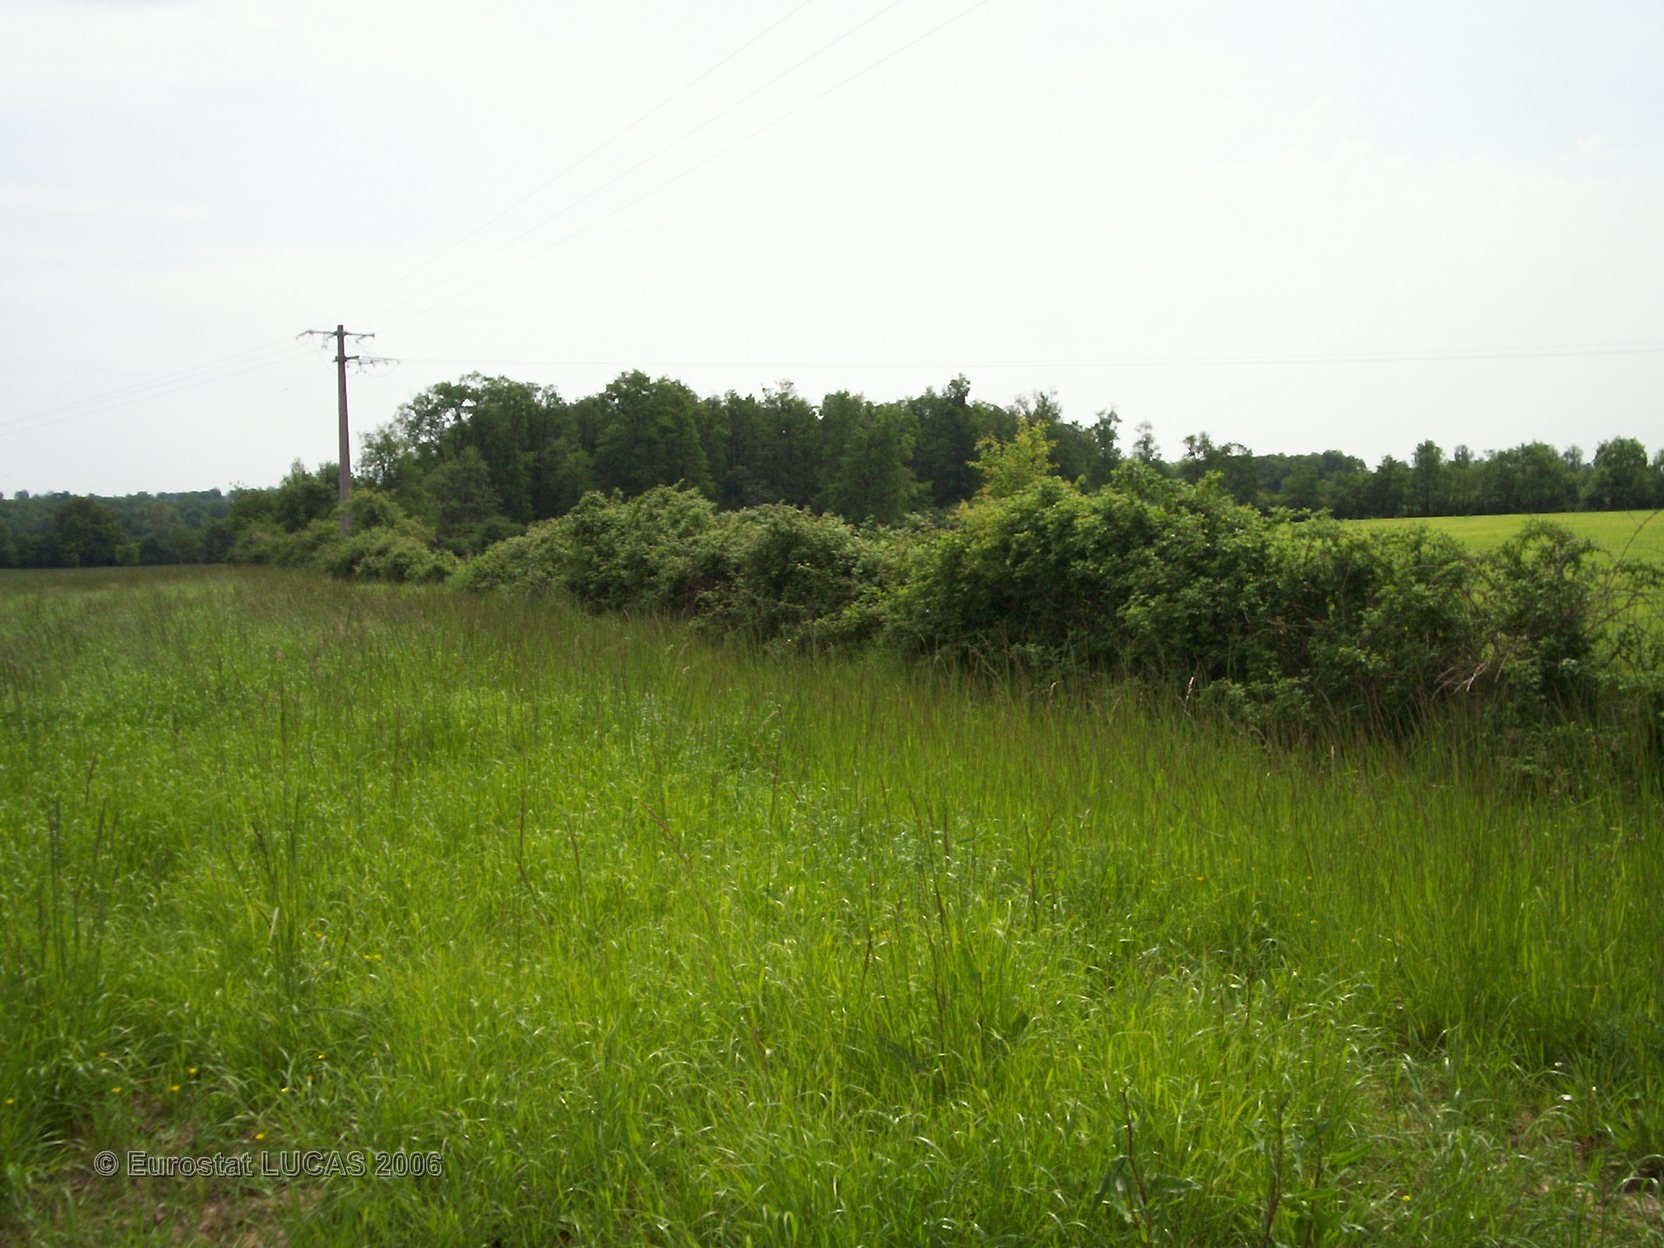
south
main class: Grassland
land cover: Grassland without tree/shrub cover
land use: Agriculture (excluding fallow land and kitchen gardens)
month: May
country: FR
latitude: 46.7517
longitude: 1.0184
